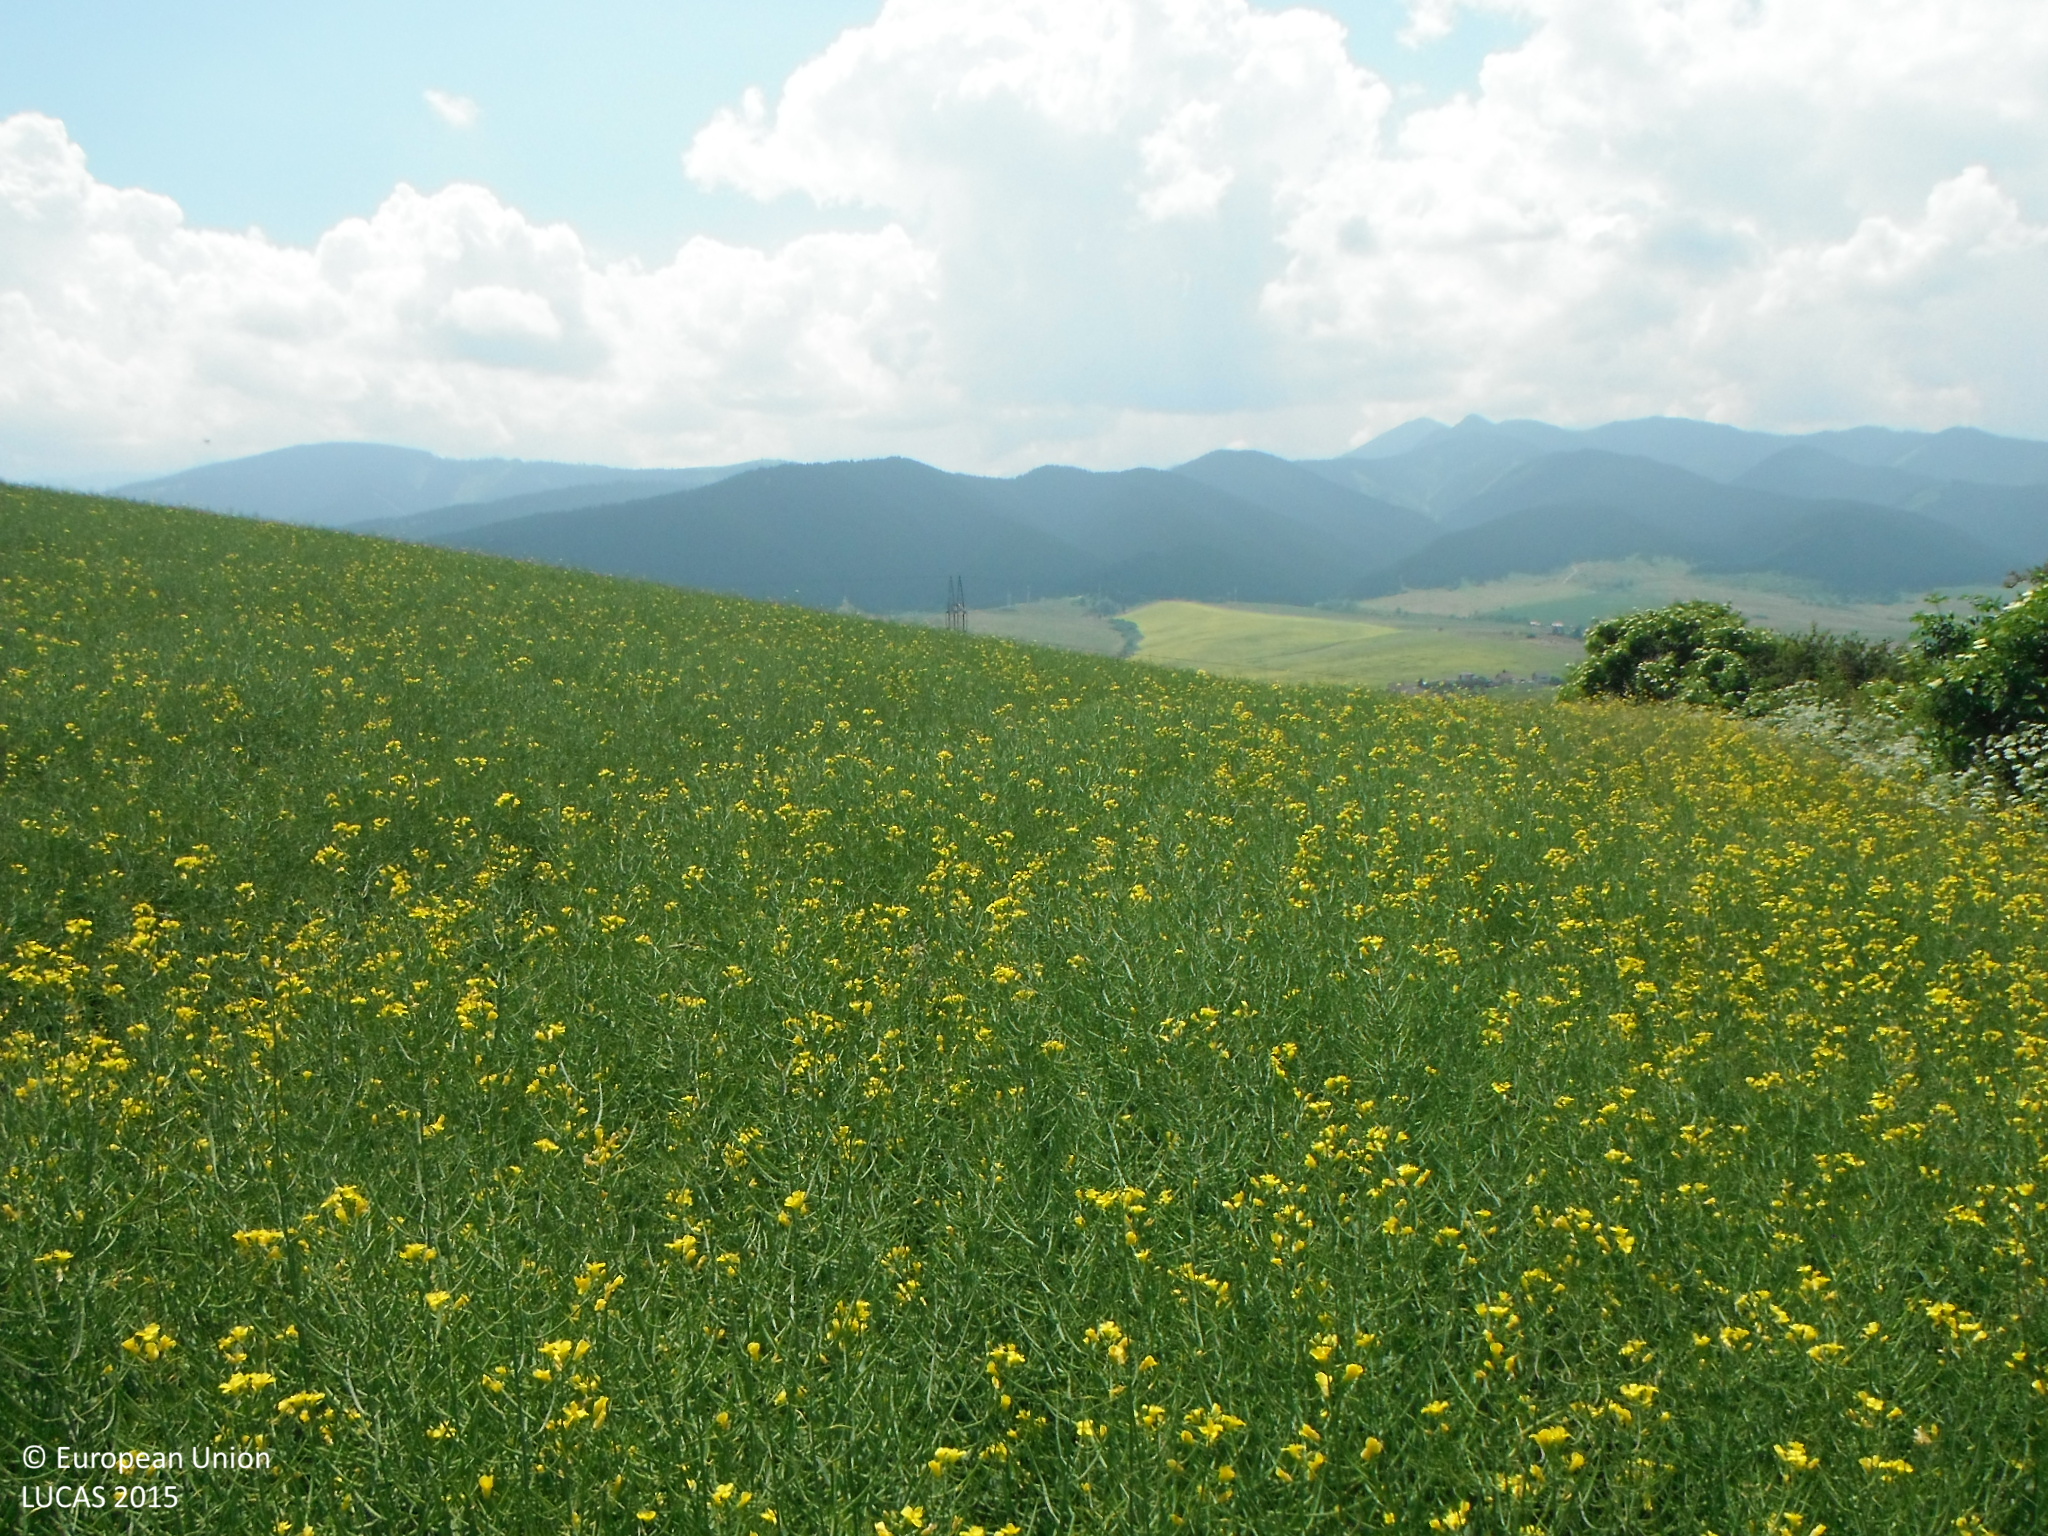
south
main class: Cropland
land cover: Rape and turnip rape
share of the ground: > 75 %
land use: Agriculture (excluding fallow land and kitchen gardens)
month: June
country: SK
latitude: 49.0707
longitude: 19.4016
